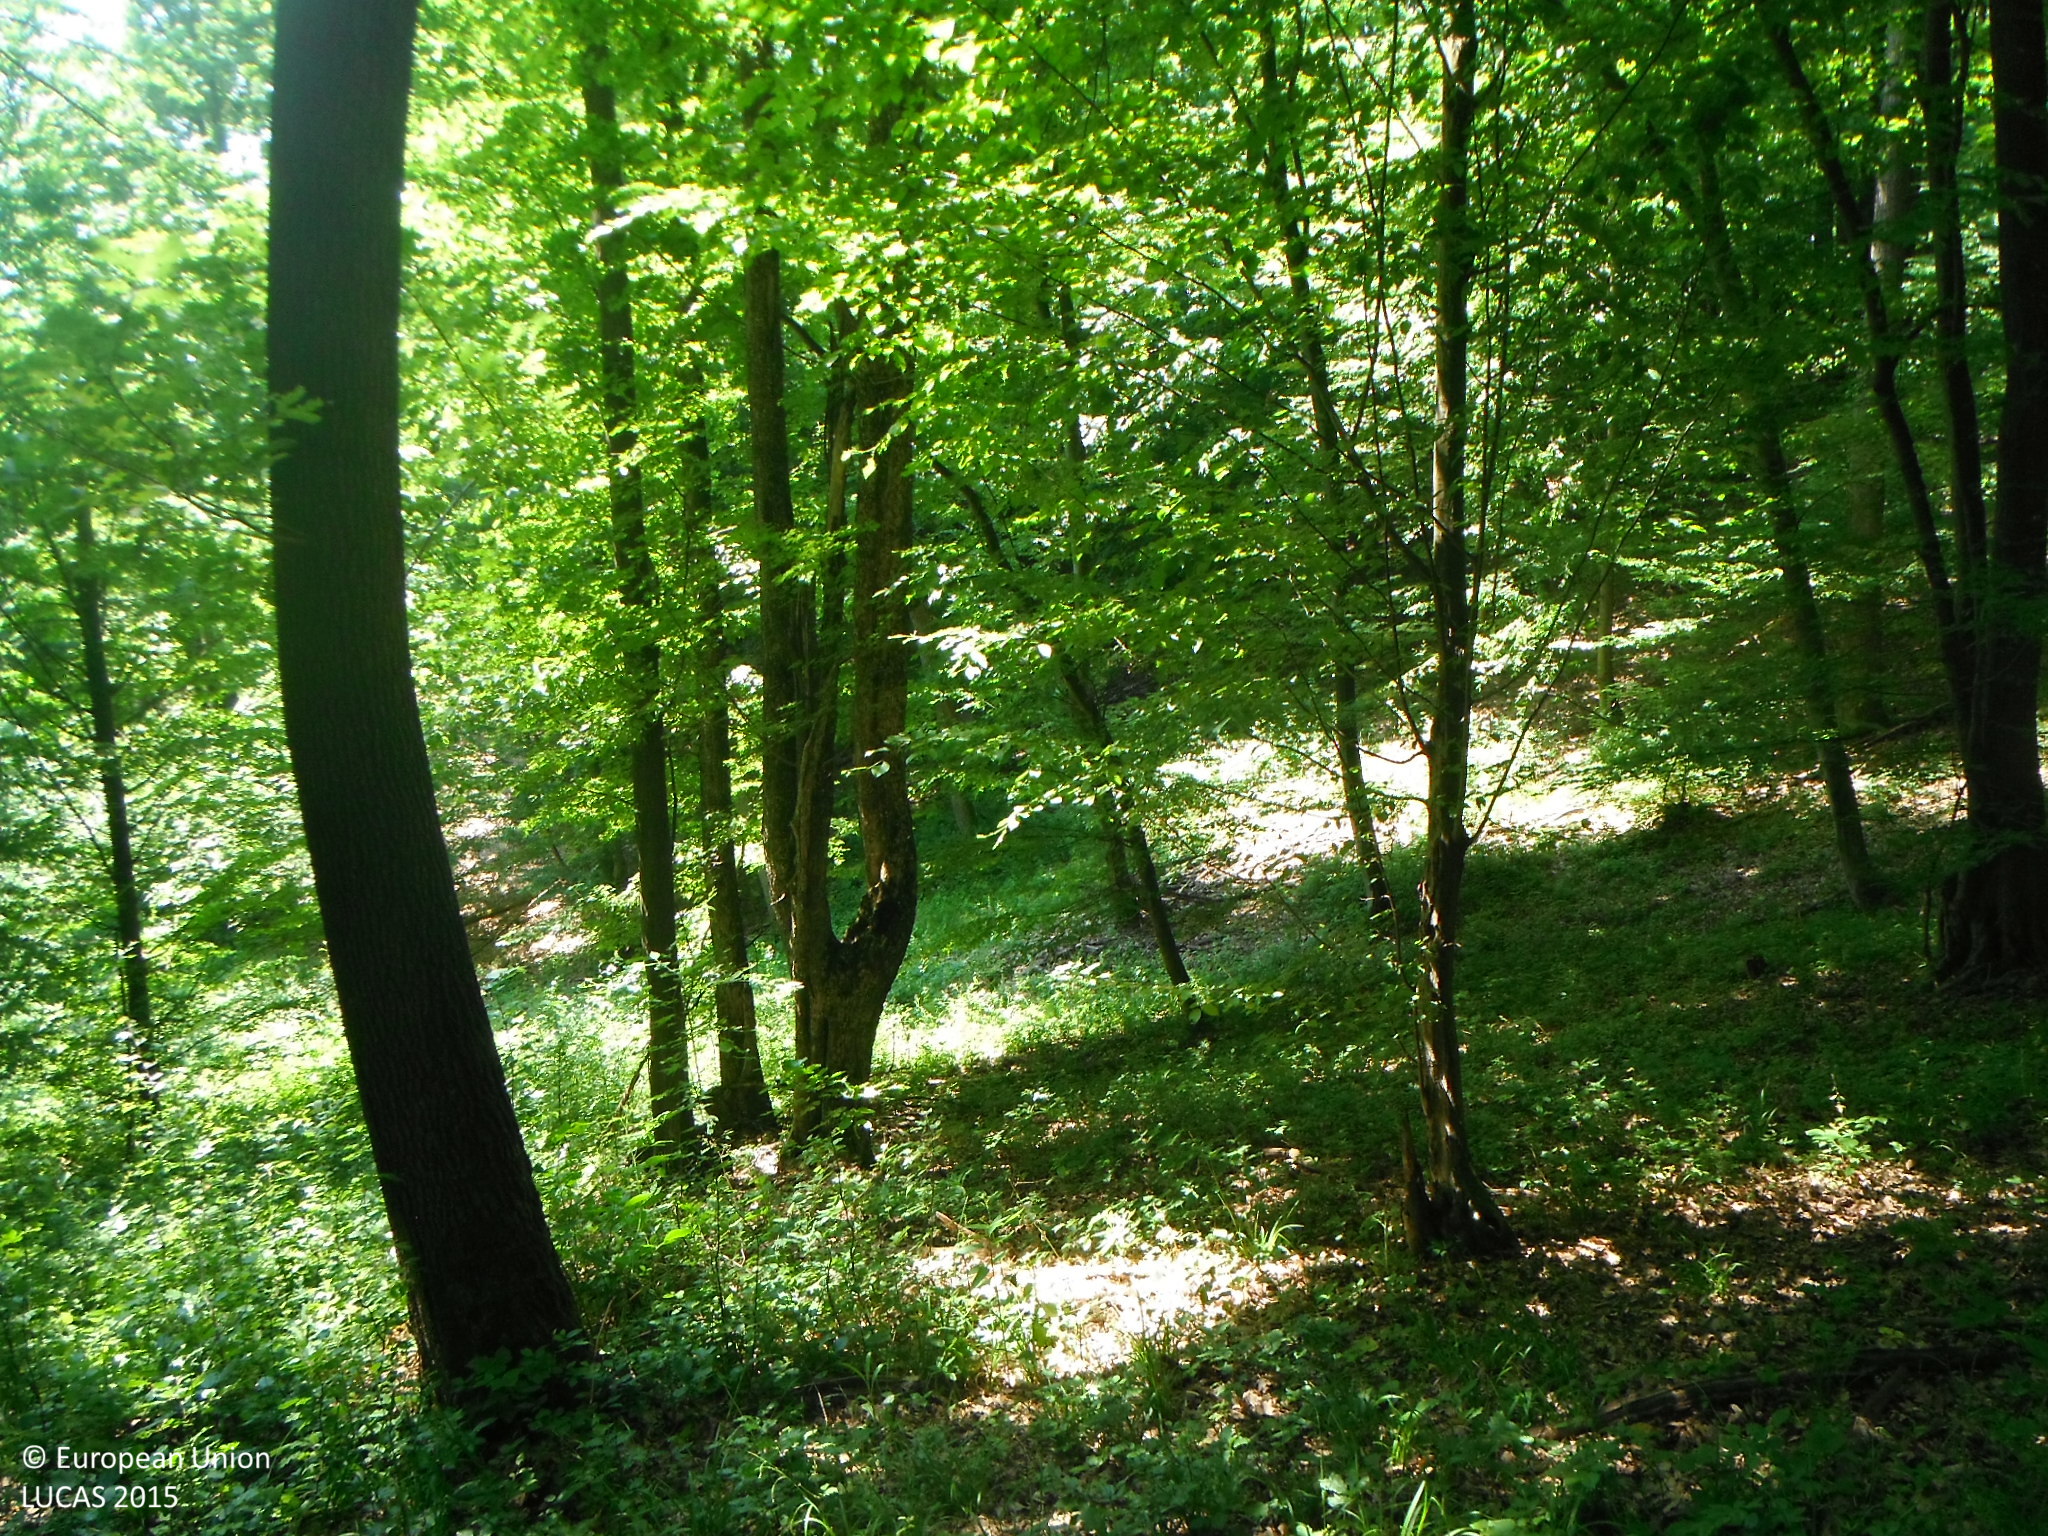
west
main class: Woodland
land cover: Broadleaved woodland
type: mesophytic deciduous forest
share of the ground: > 75 %
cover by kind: broadleaved forest trees 100 %
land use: Forestry
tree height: > 5 m
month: June
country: SK
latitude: 48.6720
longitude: 19.1889
